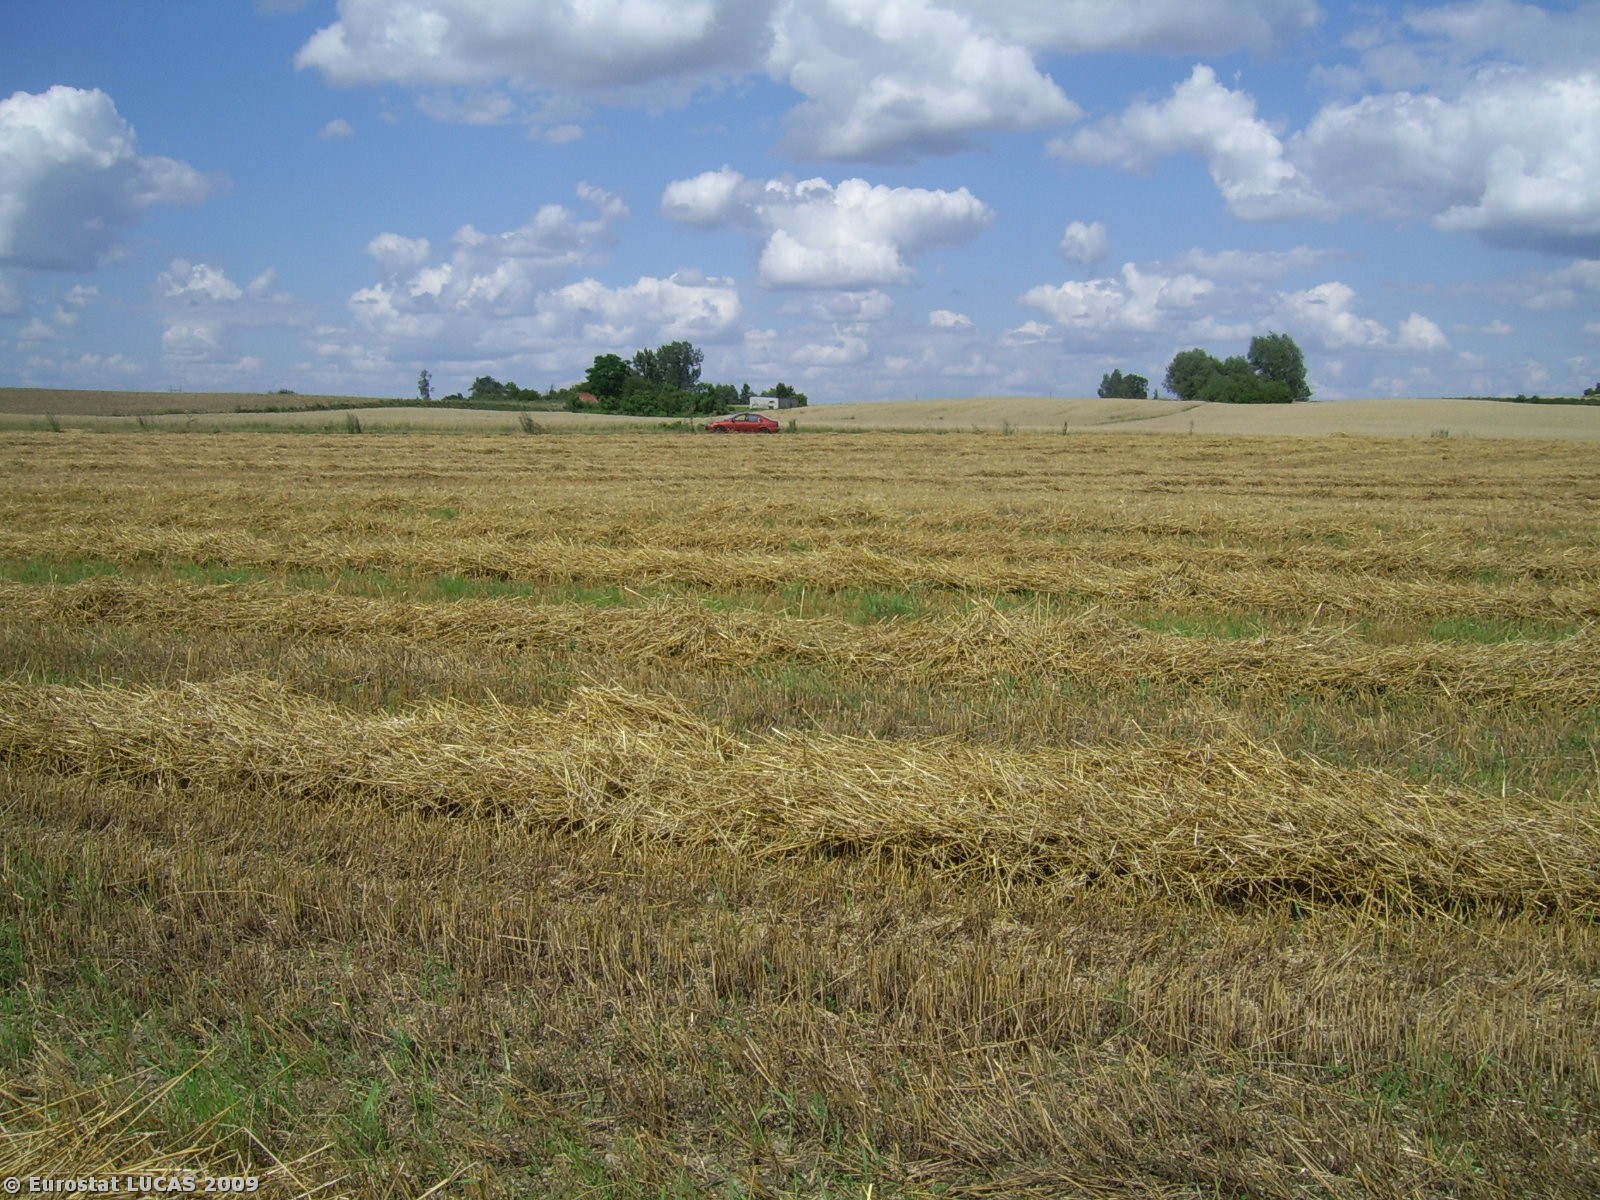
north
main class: Cropland
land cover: Common wheat
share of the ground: > 75 %
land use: Agriculture (excluding fallow land and kitchen gardens)
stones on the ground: < 10 %
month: August
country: PL
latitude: 53.0488
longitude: 18.7473
